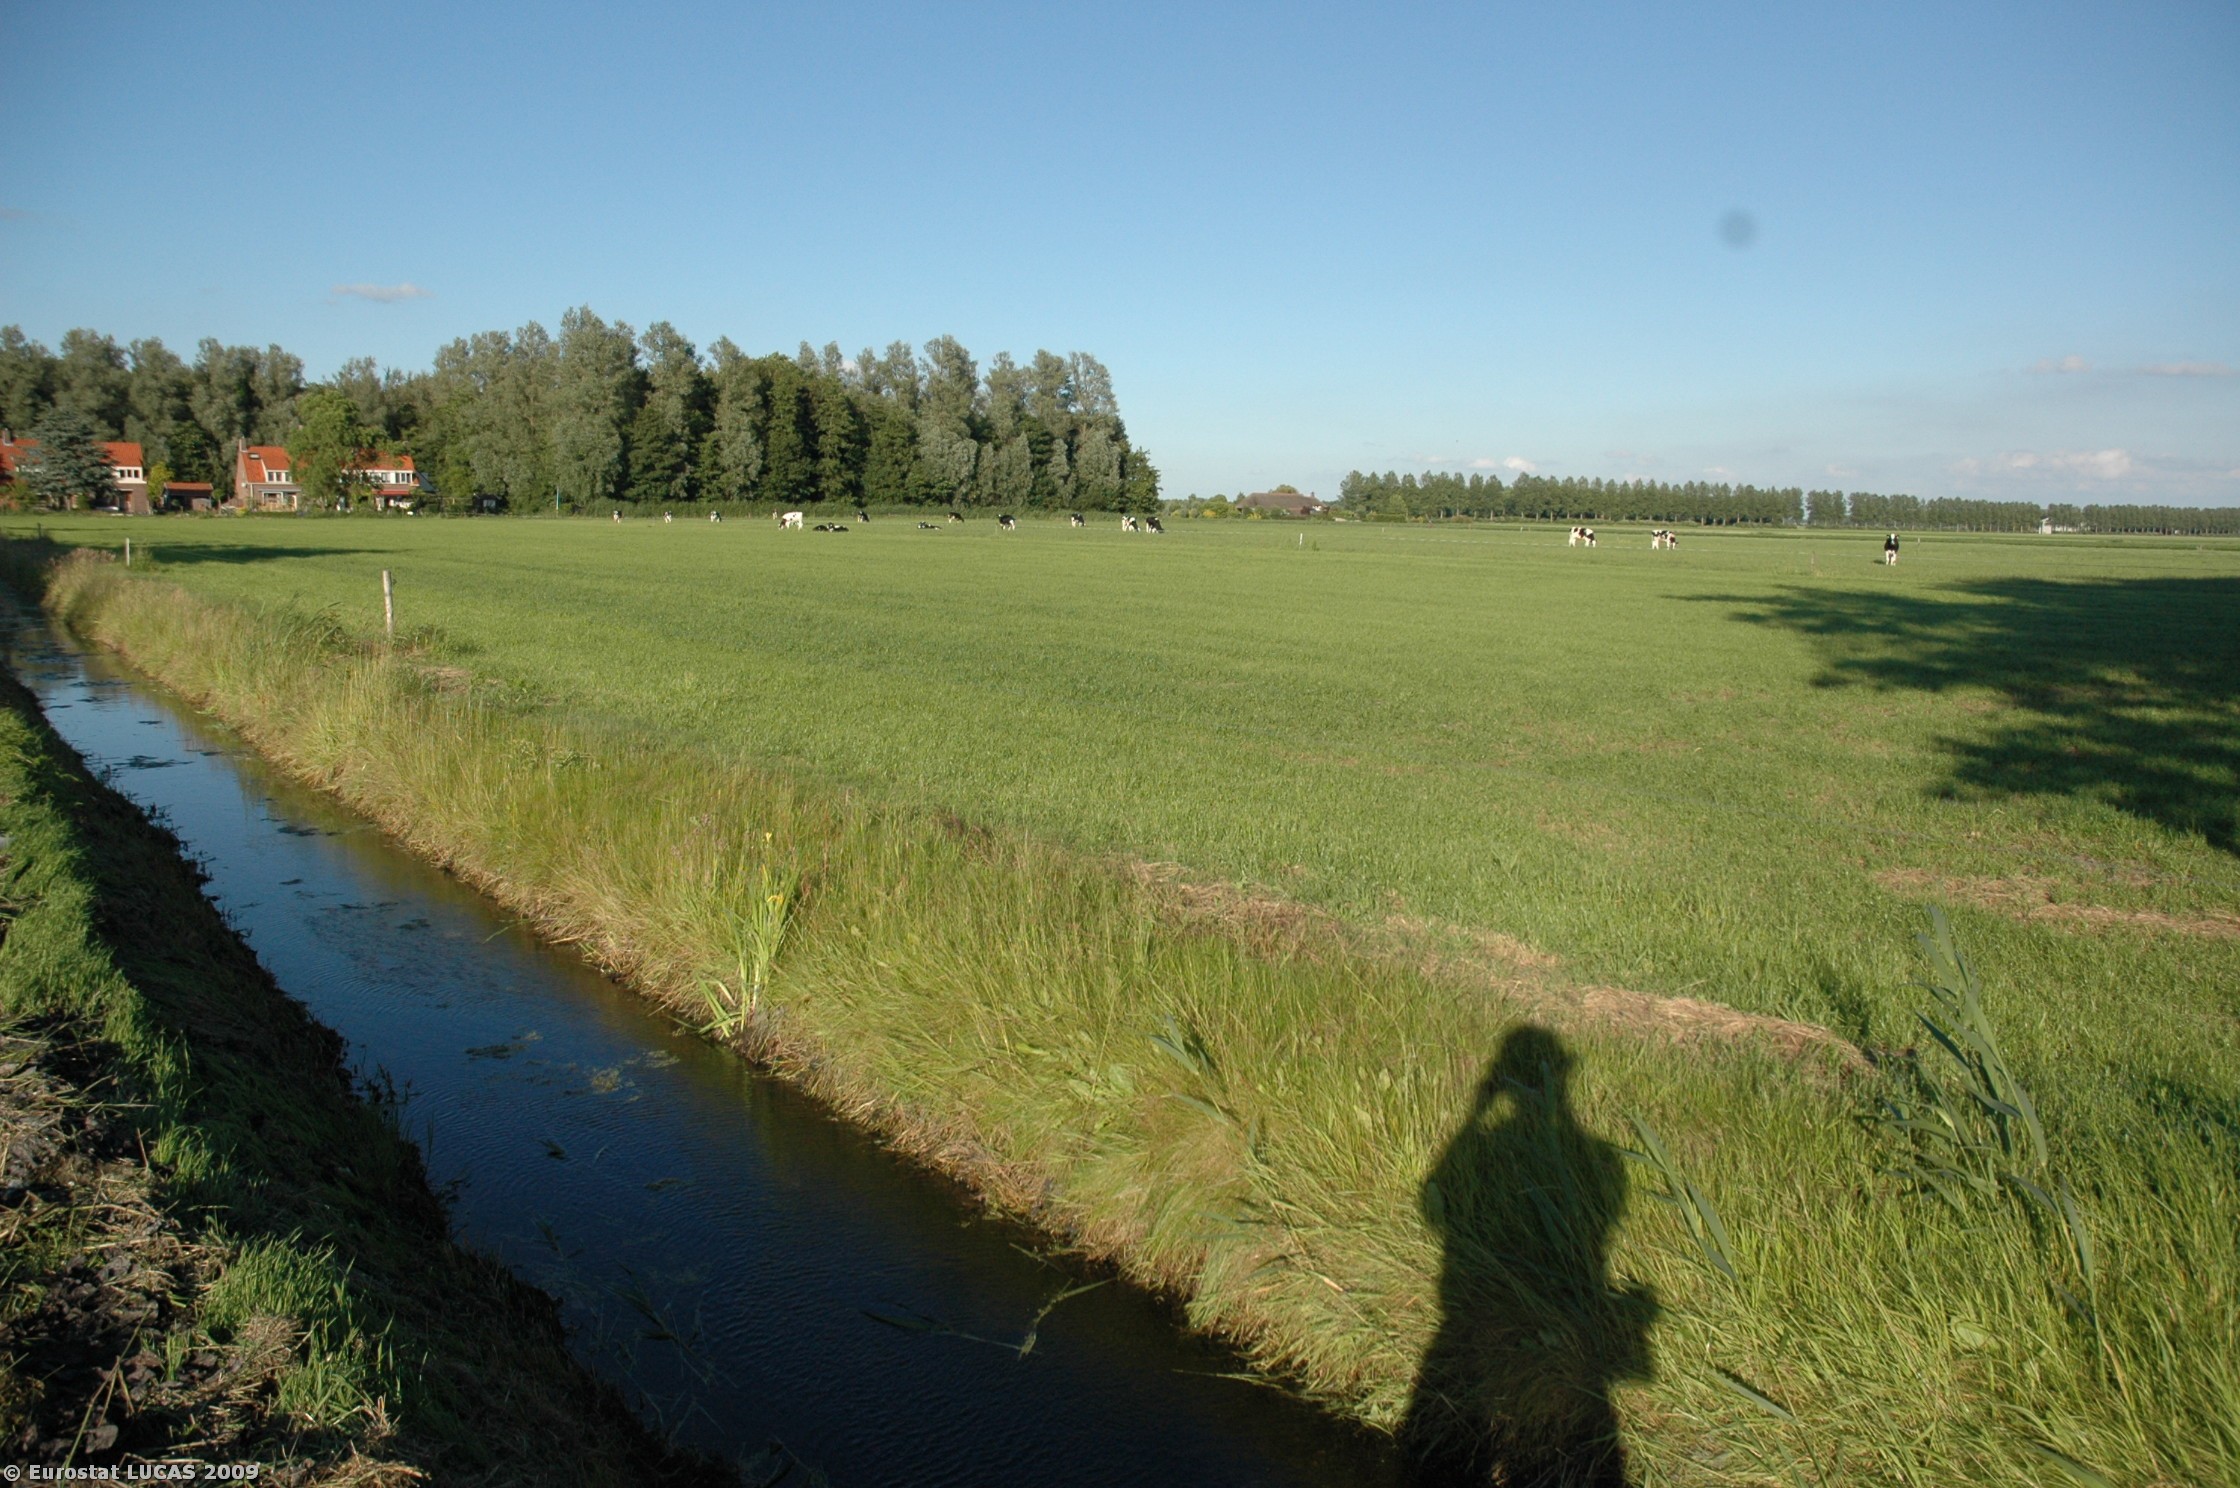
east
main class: Grassland
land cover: Grassland without tree/shrub cover
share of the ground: > 75 %
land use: Agriculture (excluding fallow land and kitchen gardens)
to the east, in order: Grassland without tree/shrub cover; Fences; Grass margins; Ditches and canals; Grass margins; Spontaneously vegetated surfaces; Potatoes
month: June
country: NL
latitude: 52.6753
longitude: 5.6358
